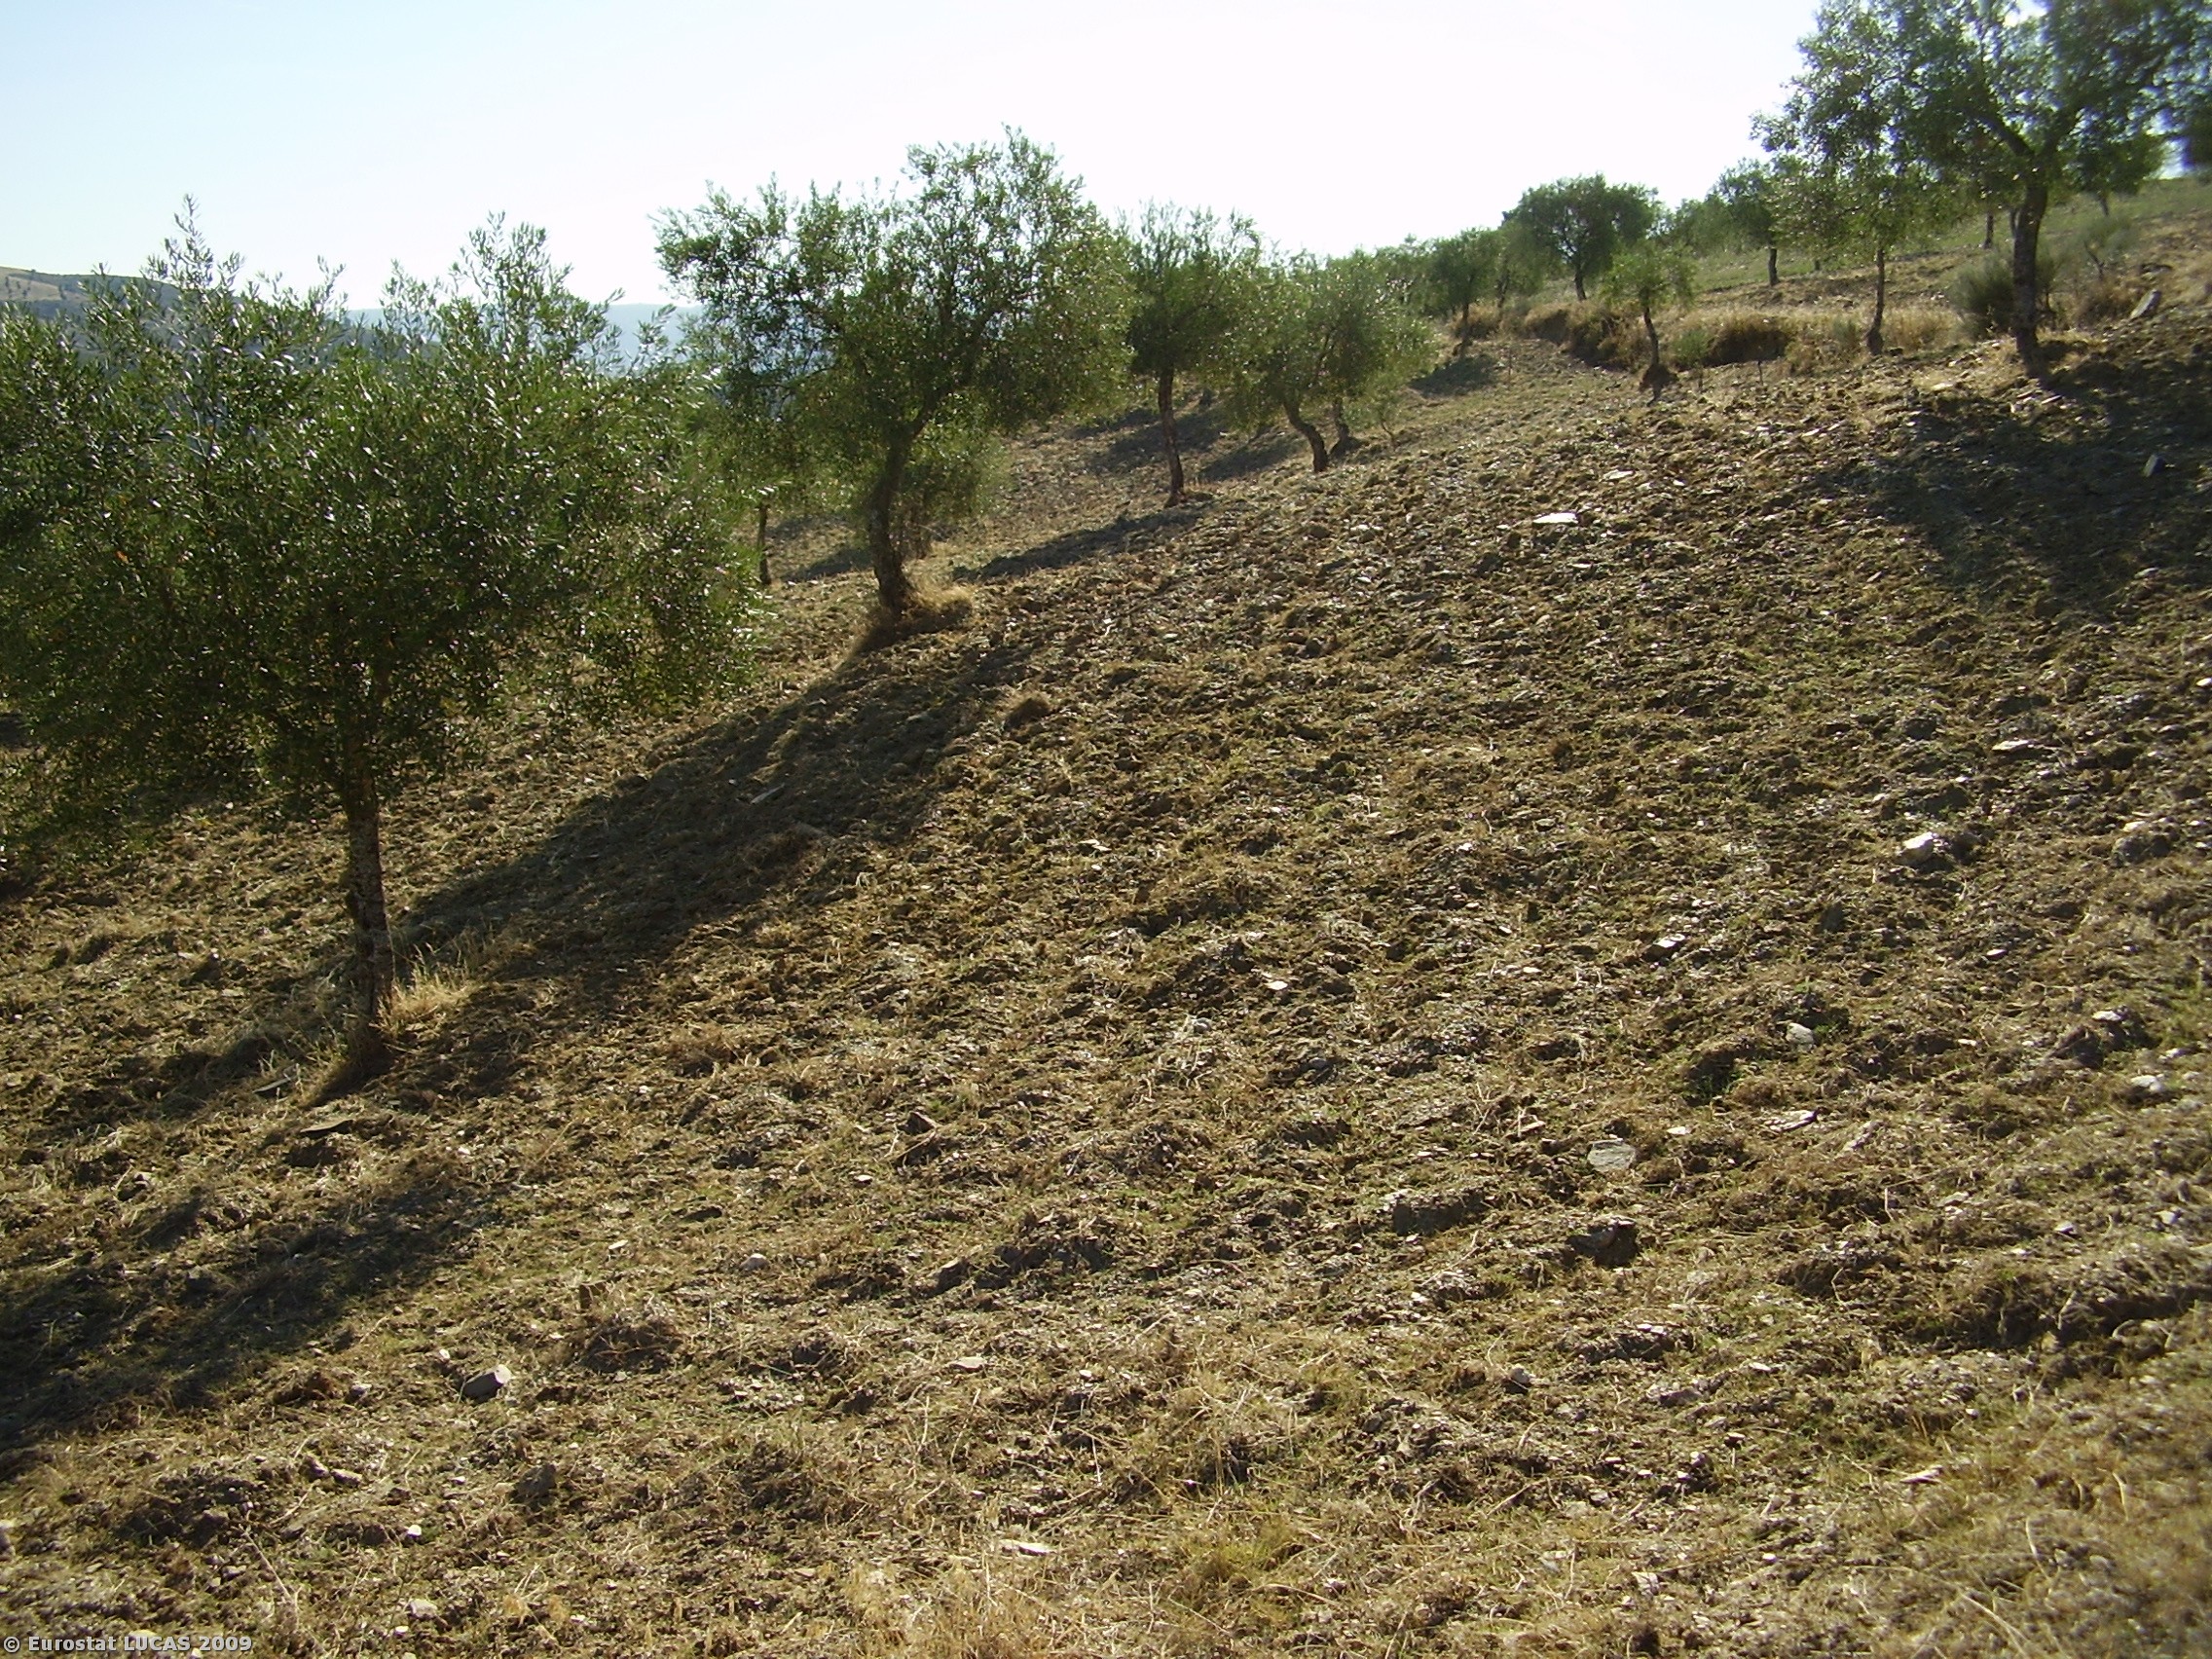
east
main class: Cropland
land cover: Olive groves
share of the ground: 10 - 25 %
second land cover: Spontaneously vegetated surfaces
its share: < 10 %
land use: Agriculture (excluding fallow land and kitchen gardens)
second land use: Fallow land
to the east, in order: Olive groves; Spontaneously vegetated surfaces; Olive groves; Shrubland with sparse tree cover; Spontaneously vegetated surfaces; Shrubland with sparse tree cover
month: August
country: PT
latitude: 41.4270
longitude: -6.7768
